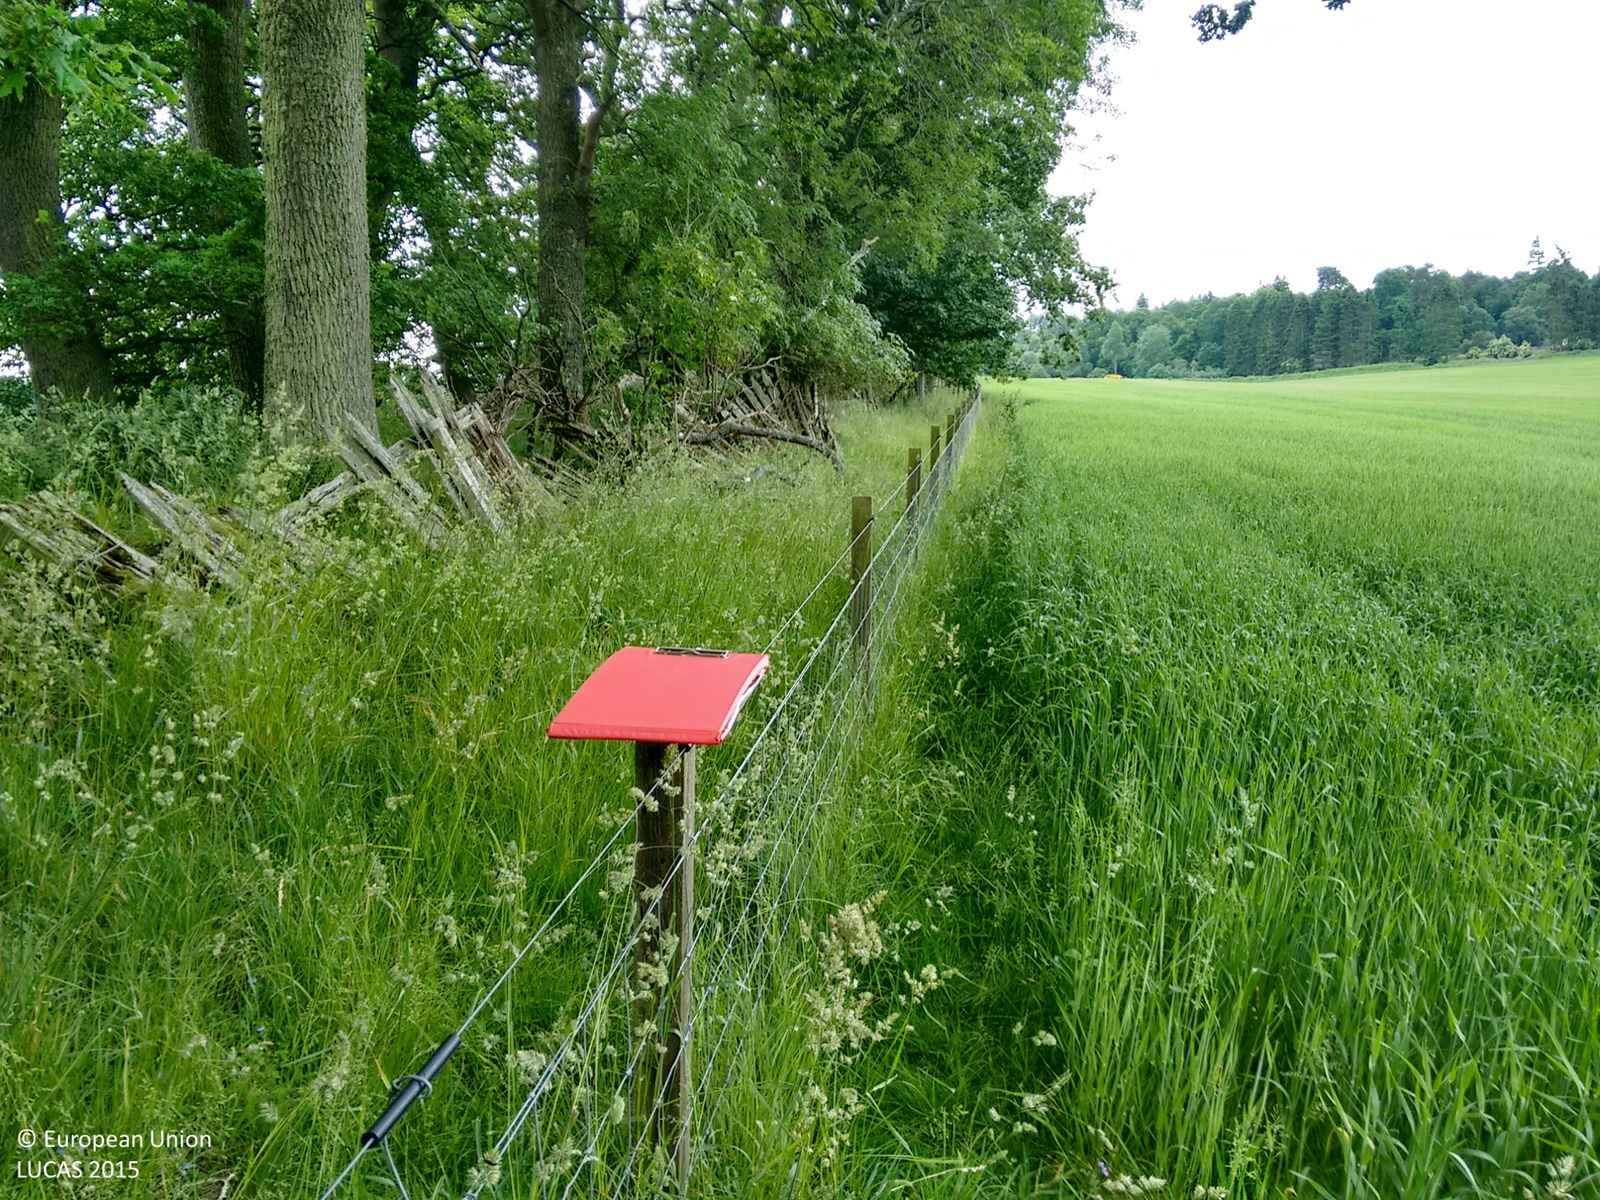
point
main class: Woodland
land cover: Broadleaved woodland
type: mesophytic deciduous forest
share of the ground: > 75 %
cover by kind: broadleaved forest trees 100 %
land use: Agriculture (excluding fallow land and kitchen gardens)
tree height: > 5 m
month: June
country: GB
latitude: 56.5338
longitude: -3.4559
